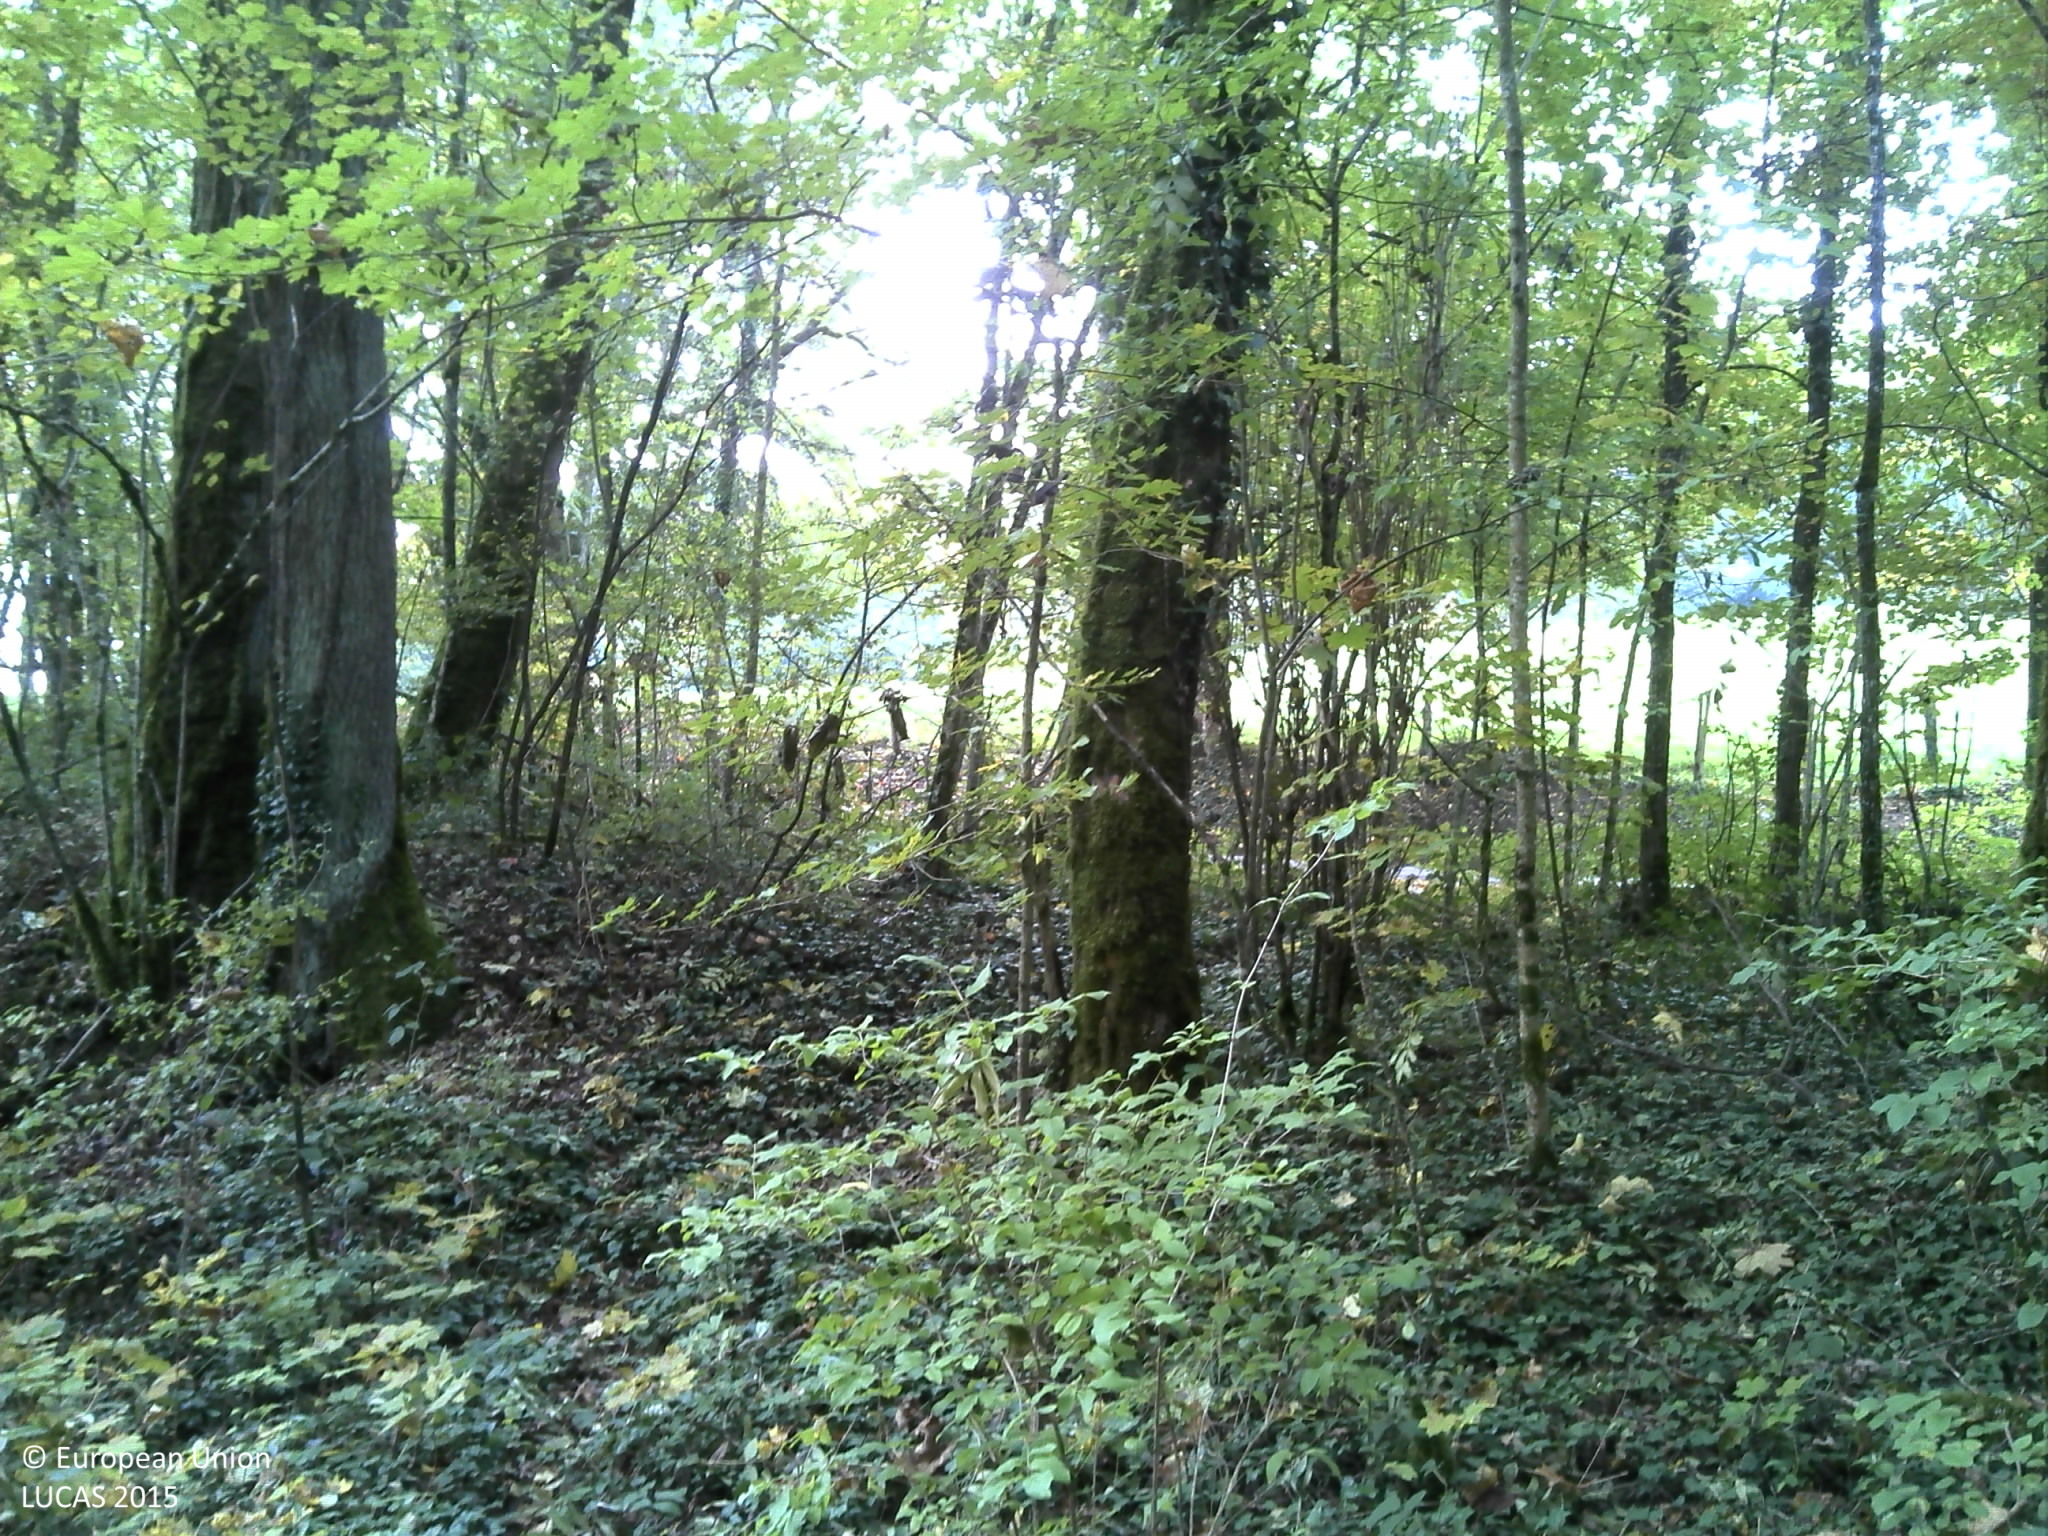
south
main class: Woodland
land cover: Broadleaved woodland
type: mesophytic deciduous forest
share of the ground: > 75 %
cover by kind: broadleaved forest trees 90 %, shrubs 5 %, herbaceous plants 5 %
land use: Forestry
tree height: > 5 m
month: October
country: FR
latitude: 46.0882
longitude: 5.3604
